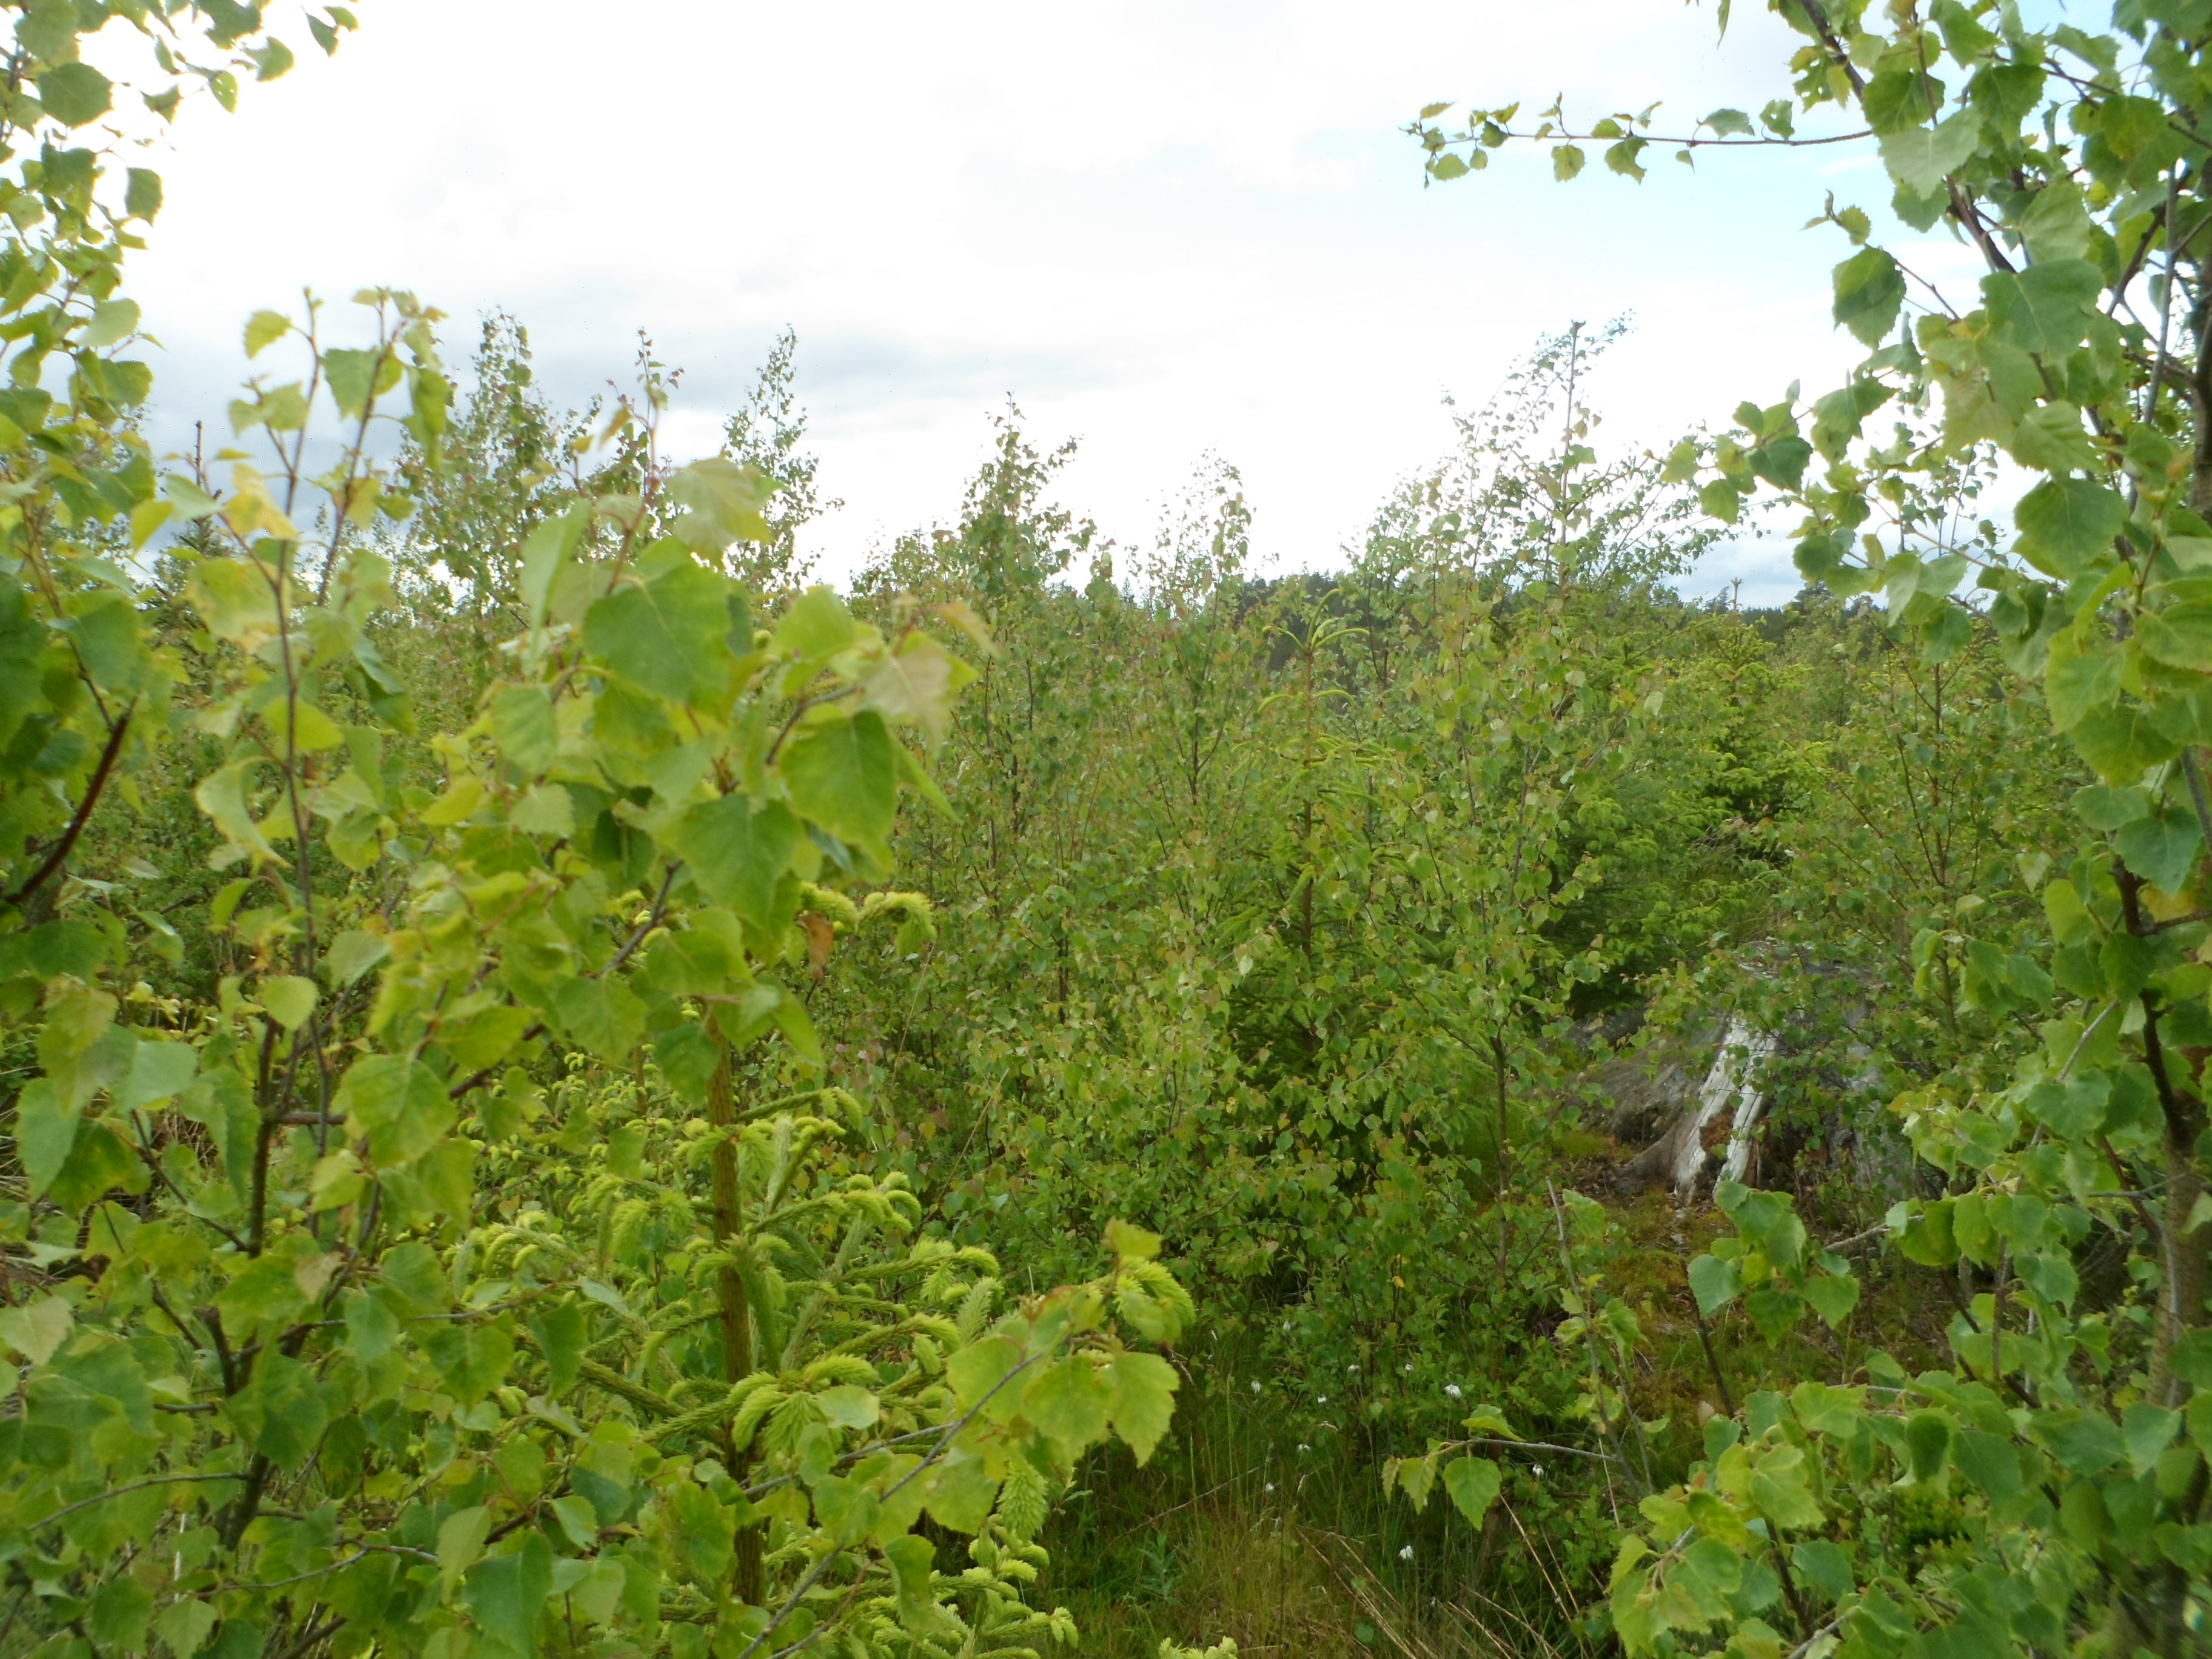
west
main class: Woodland
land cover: Spruce dominated mixed woodland
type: boreal forest
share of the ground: > 75 %
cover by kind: broadleaved forest trees 45 %, coniferous forest trees 35 %, shrubs 10 %, herbaceous plants 10 %
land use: Forestry
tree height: > 5 m
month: June
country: SE
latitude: 57.0096
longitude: 14.4921
